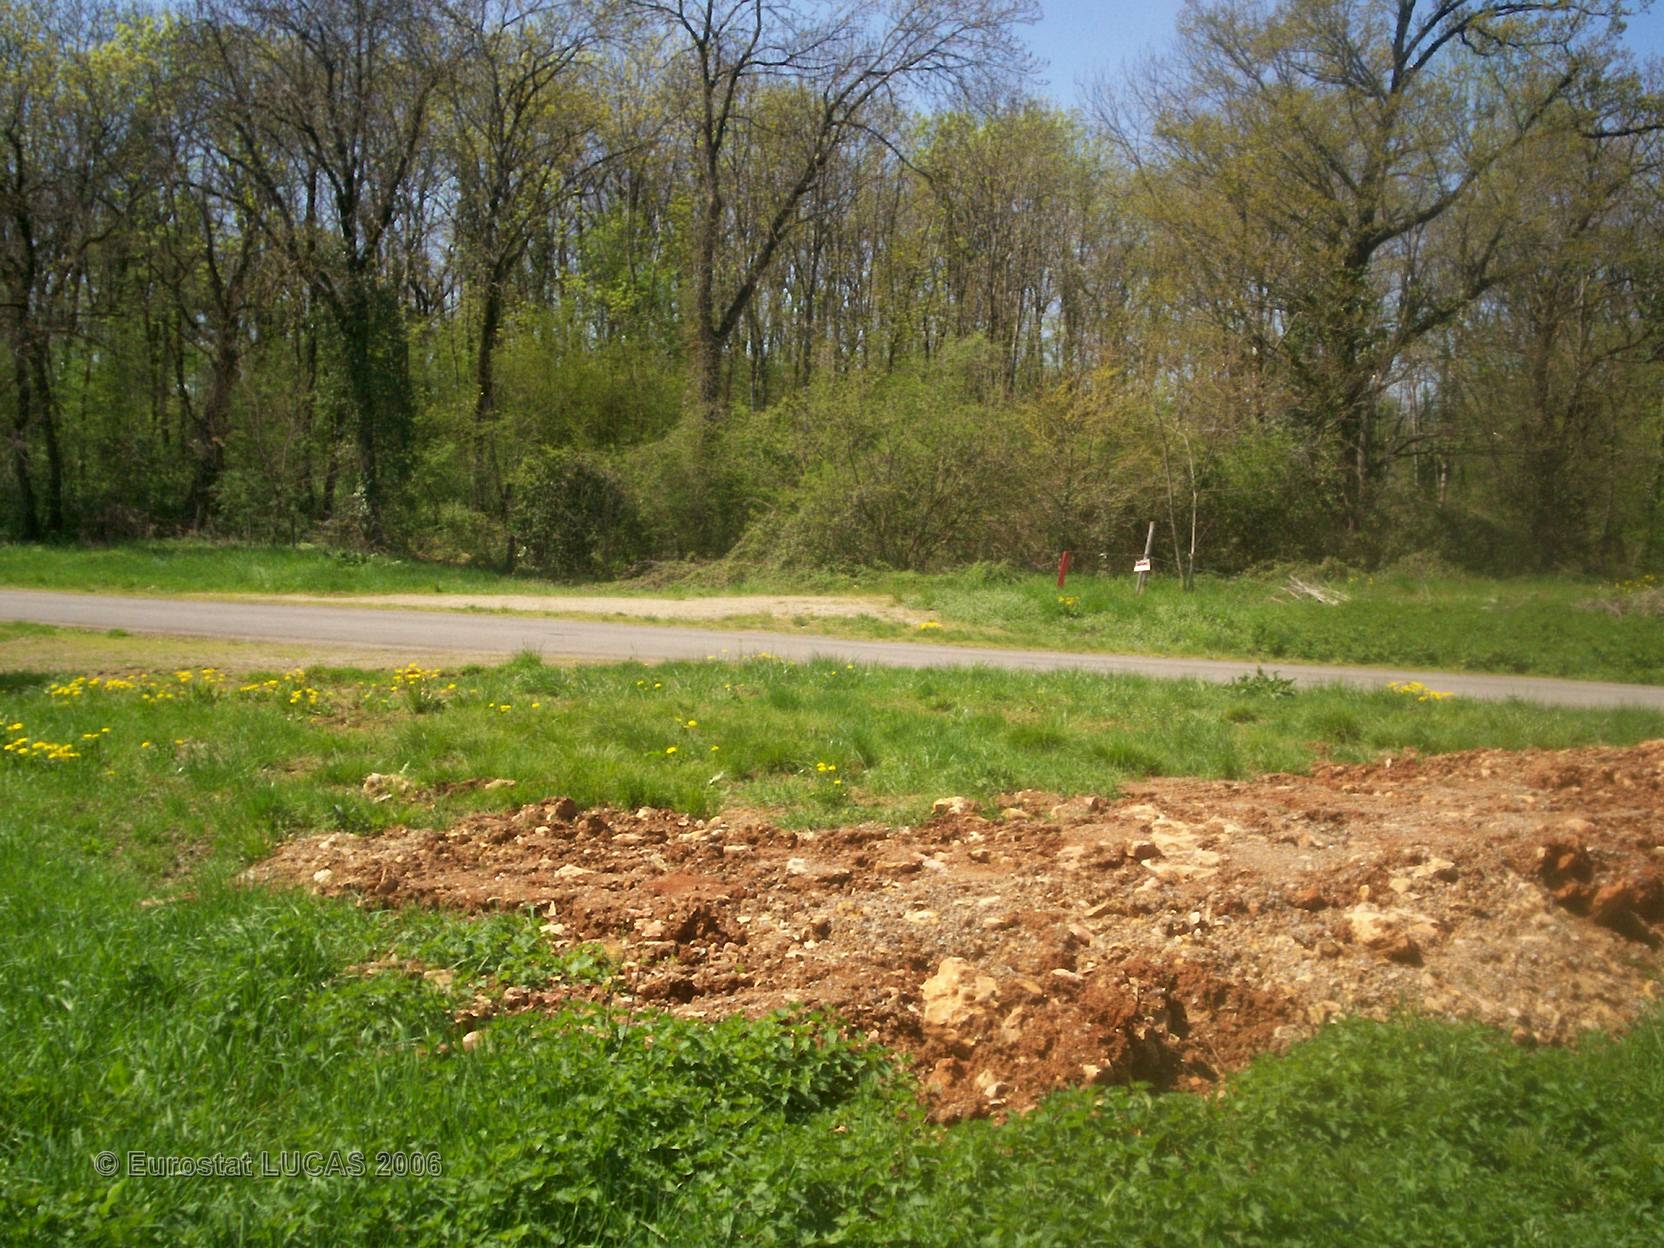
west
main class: Grassland
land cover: Grassland with sparse tree/shrub cover
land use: Fallow land
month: April
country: FR
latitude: 44.3622
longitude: 1.9329
